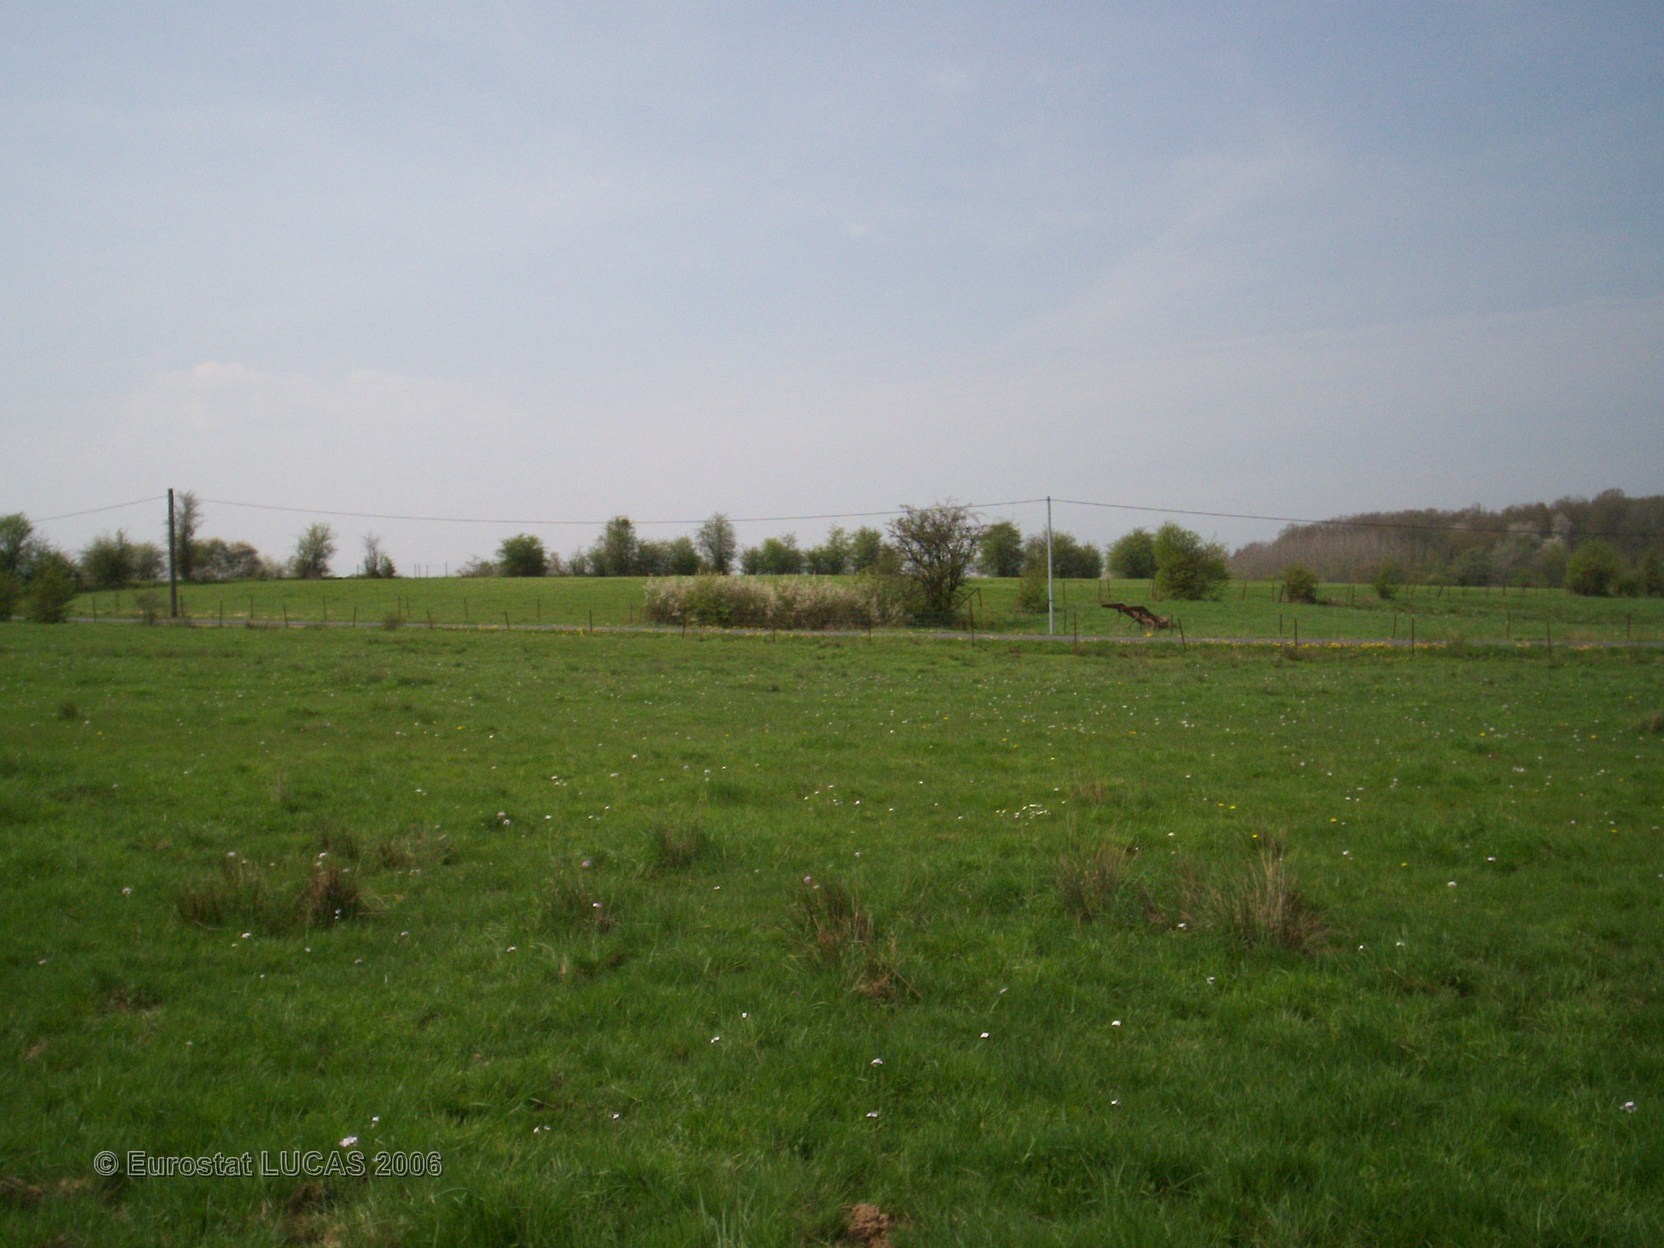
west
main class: Grassland
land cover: Grassland without tree/shrub cover
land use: Agriculture (excluding fallow land and kitchen gardens)
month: May
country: FR
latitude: 49.8796
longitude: 4.3037
